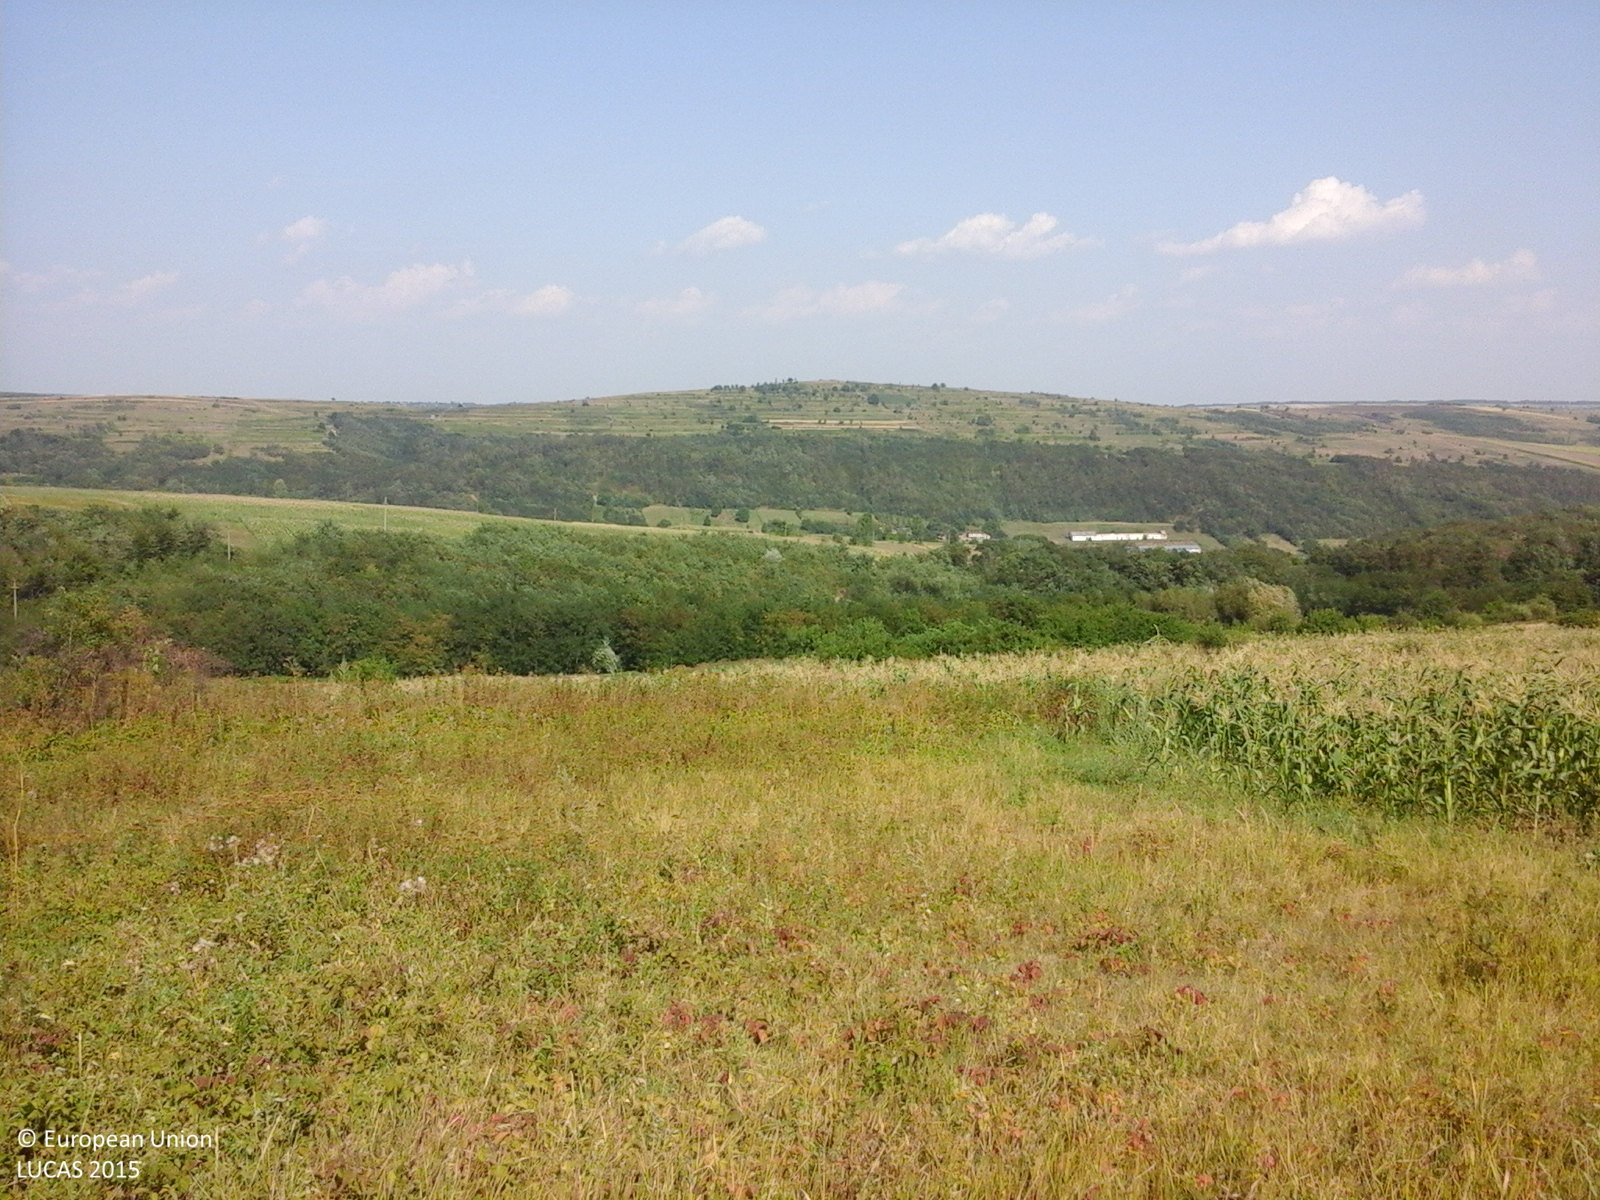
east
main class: Grassland
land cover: Spontaneously vegetated surfaces
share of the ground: > 75 %
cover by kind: herbaceous plants 100 %
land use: Agriculture (excluding fallow land and kitchen gardens)
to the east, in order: Spontaneously vegetated surfaces; Maize; Lines of trees; Maize; Lines of trees; Maize; Lines of trees; Lucerne; Lines of trees; Vineyards; Maize; Broadleaved woodland
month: July
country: RO
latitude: 46.2635
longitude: 27.3469
